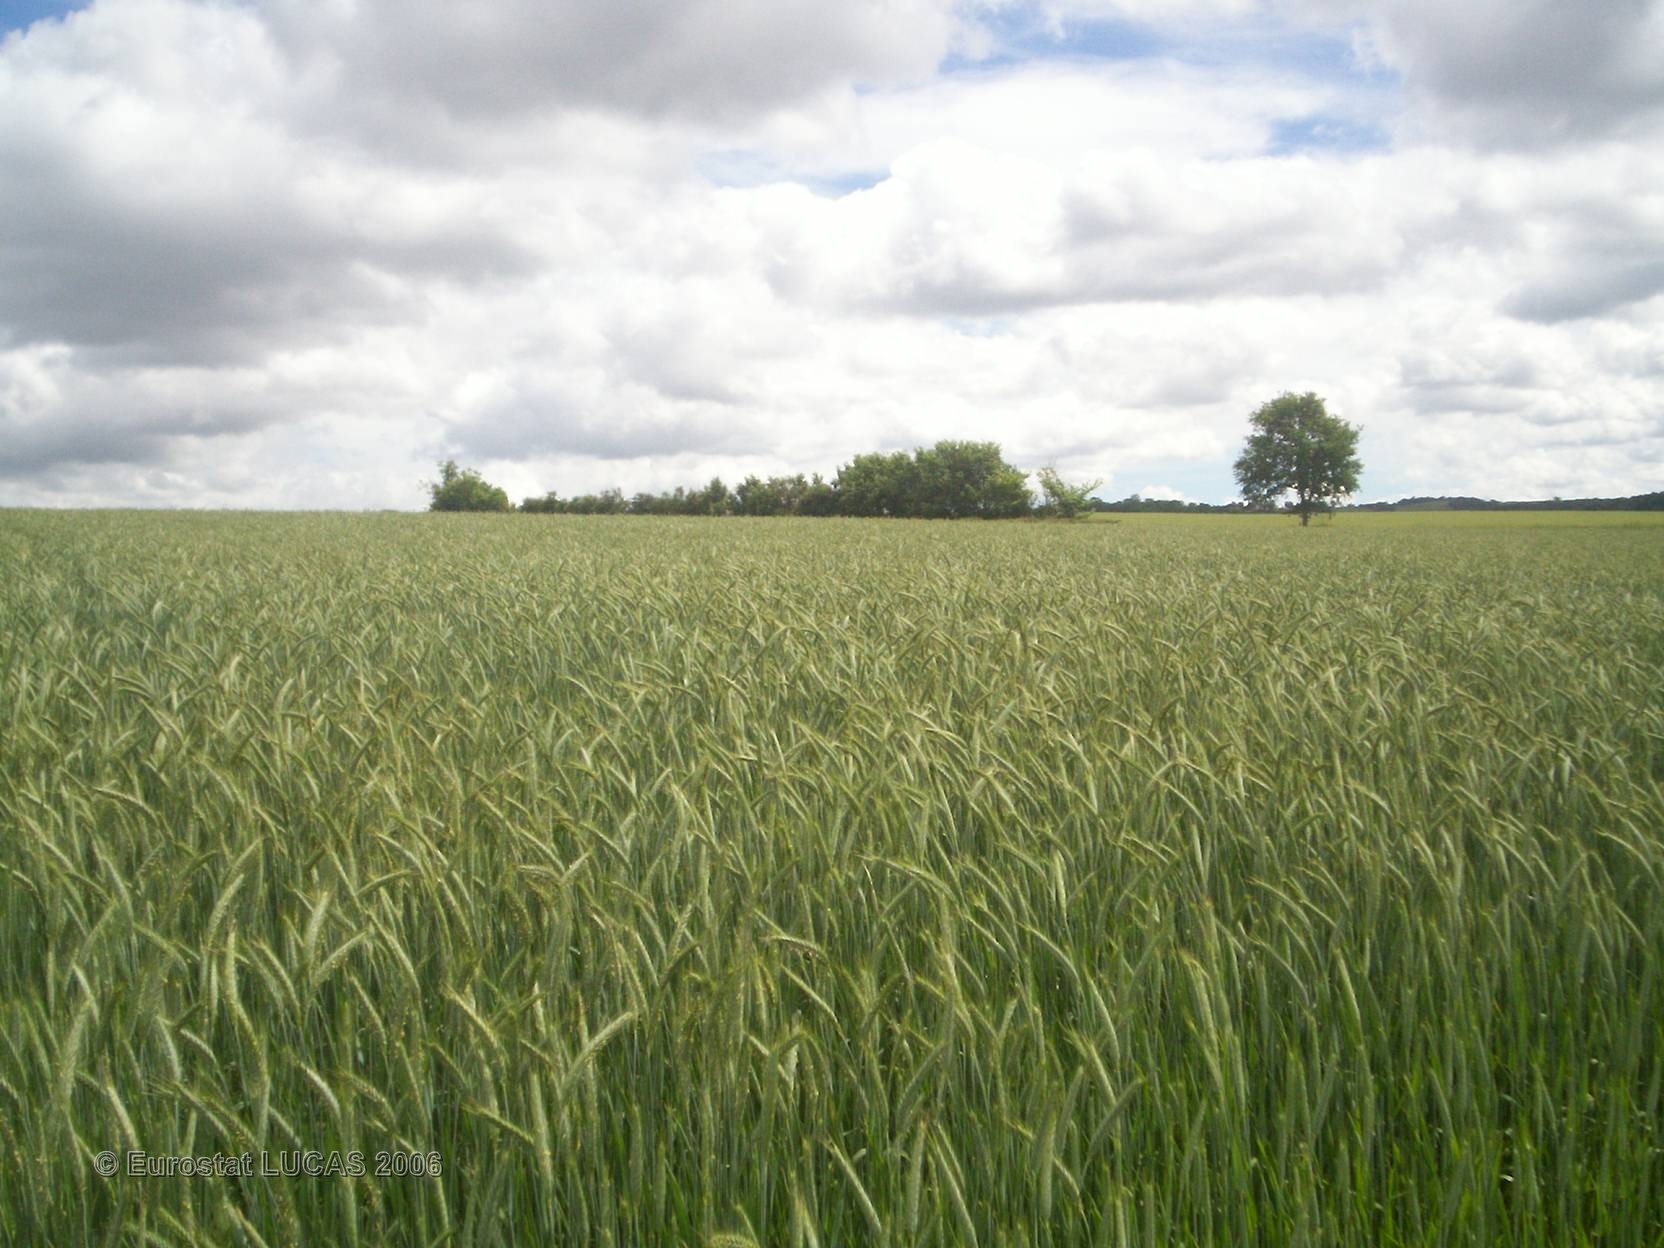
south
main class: Cropland
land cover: Triticale
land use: Agriculture (excluding fallow land and kitchen gardens)
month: May
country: FR
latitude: 46.1496
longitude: 3.1496
